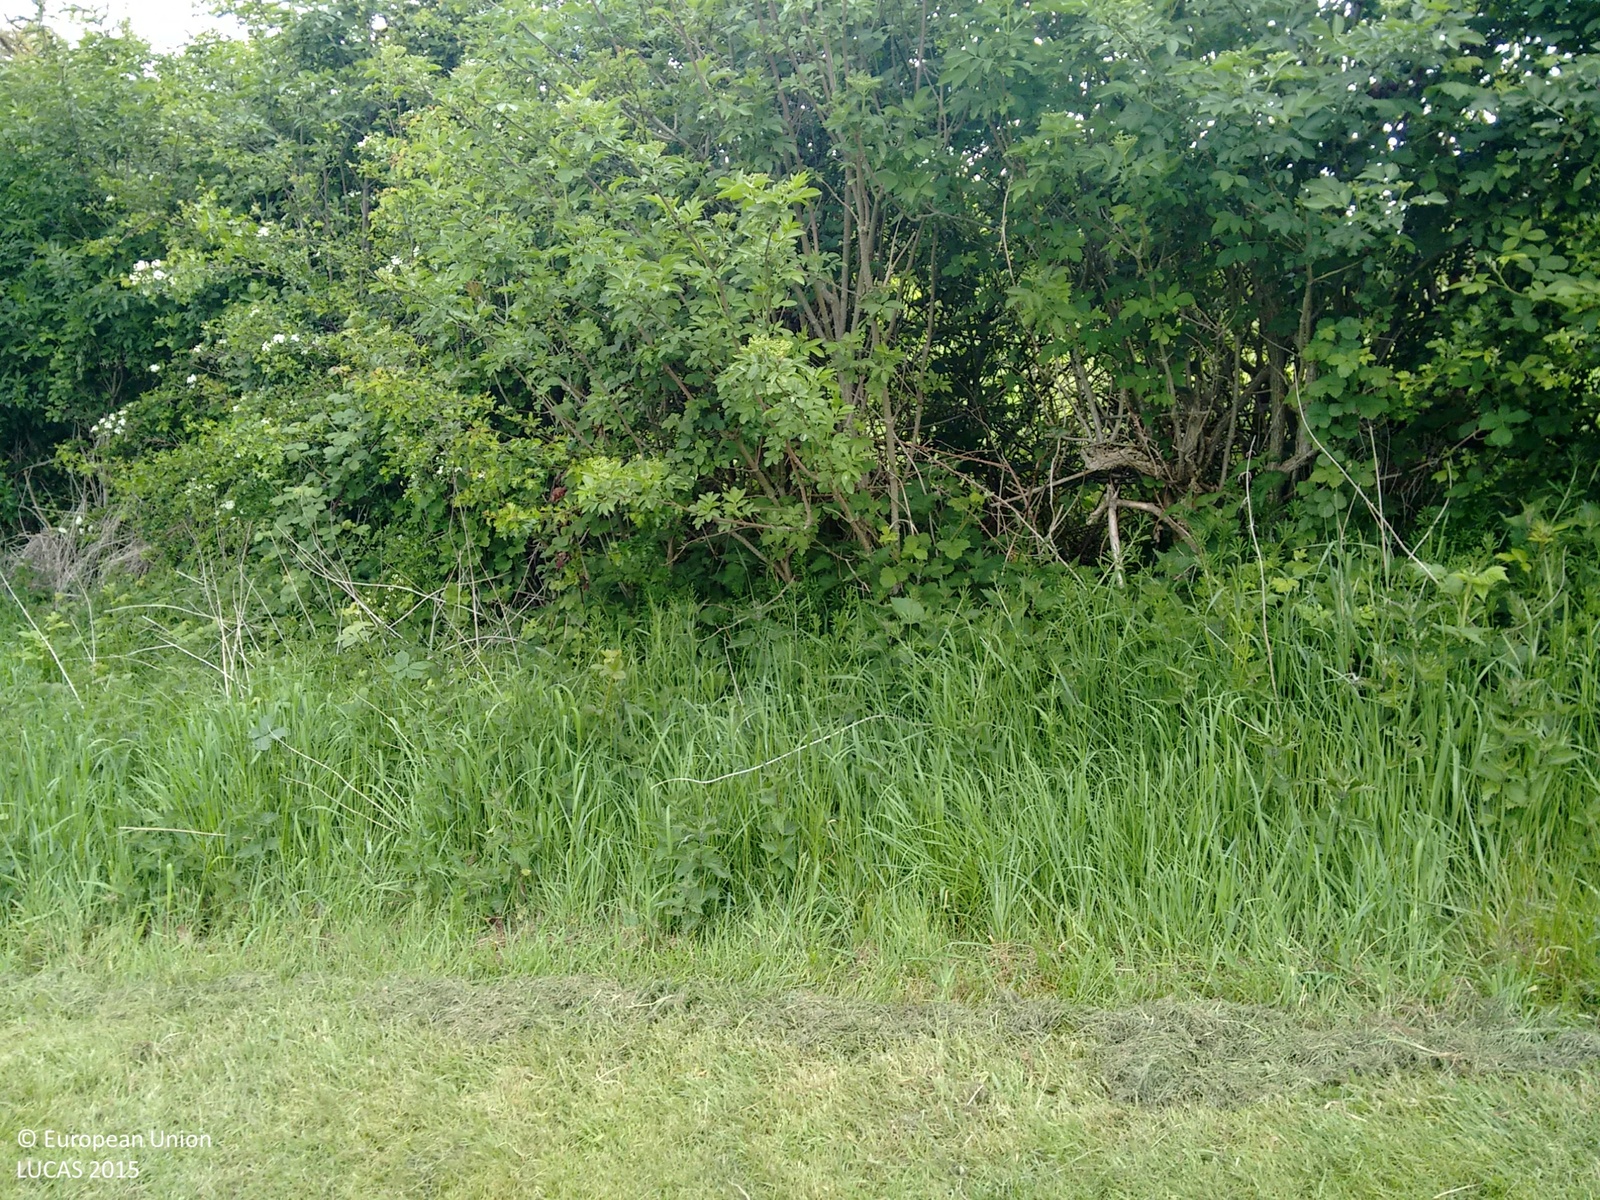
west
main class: Grassland
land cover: Grassland without tree/shrub cover
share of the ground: > 75 %
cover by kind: herbaceous plants 100 %
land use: Agriculture (excluding fallow land and kitchen gardens)
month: May
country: GB
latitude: 52.1171
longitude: -1.3970
